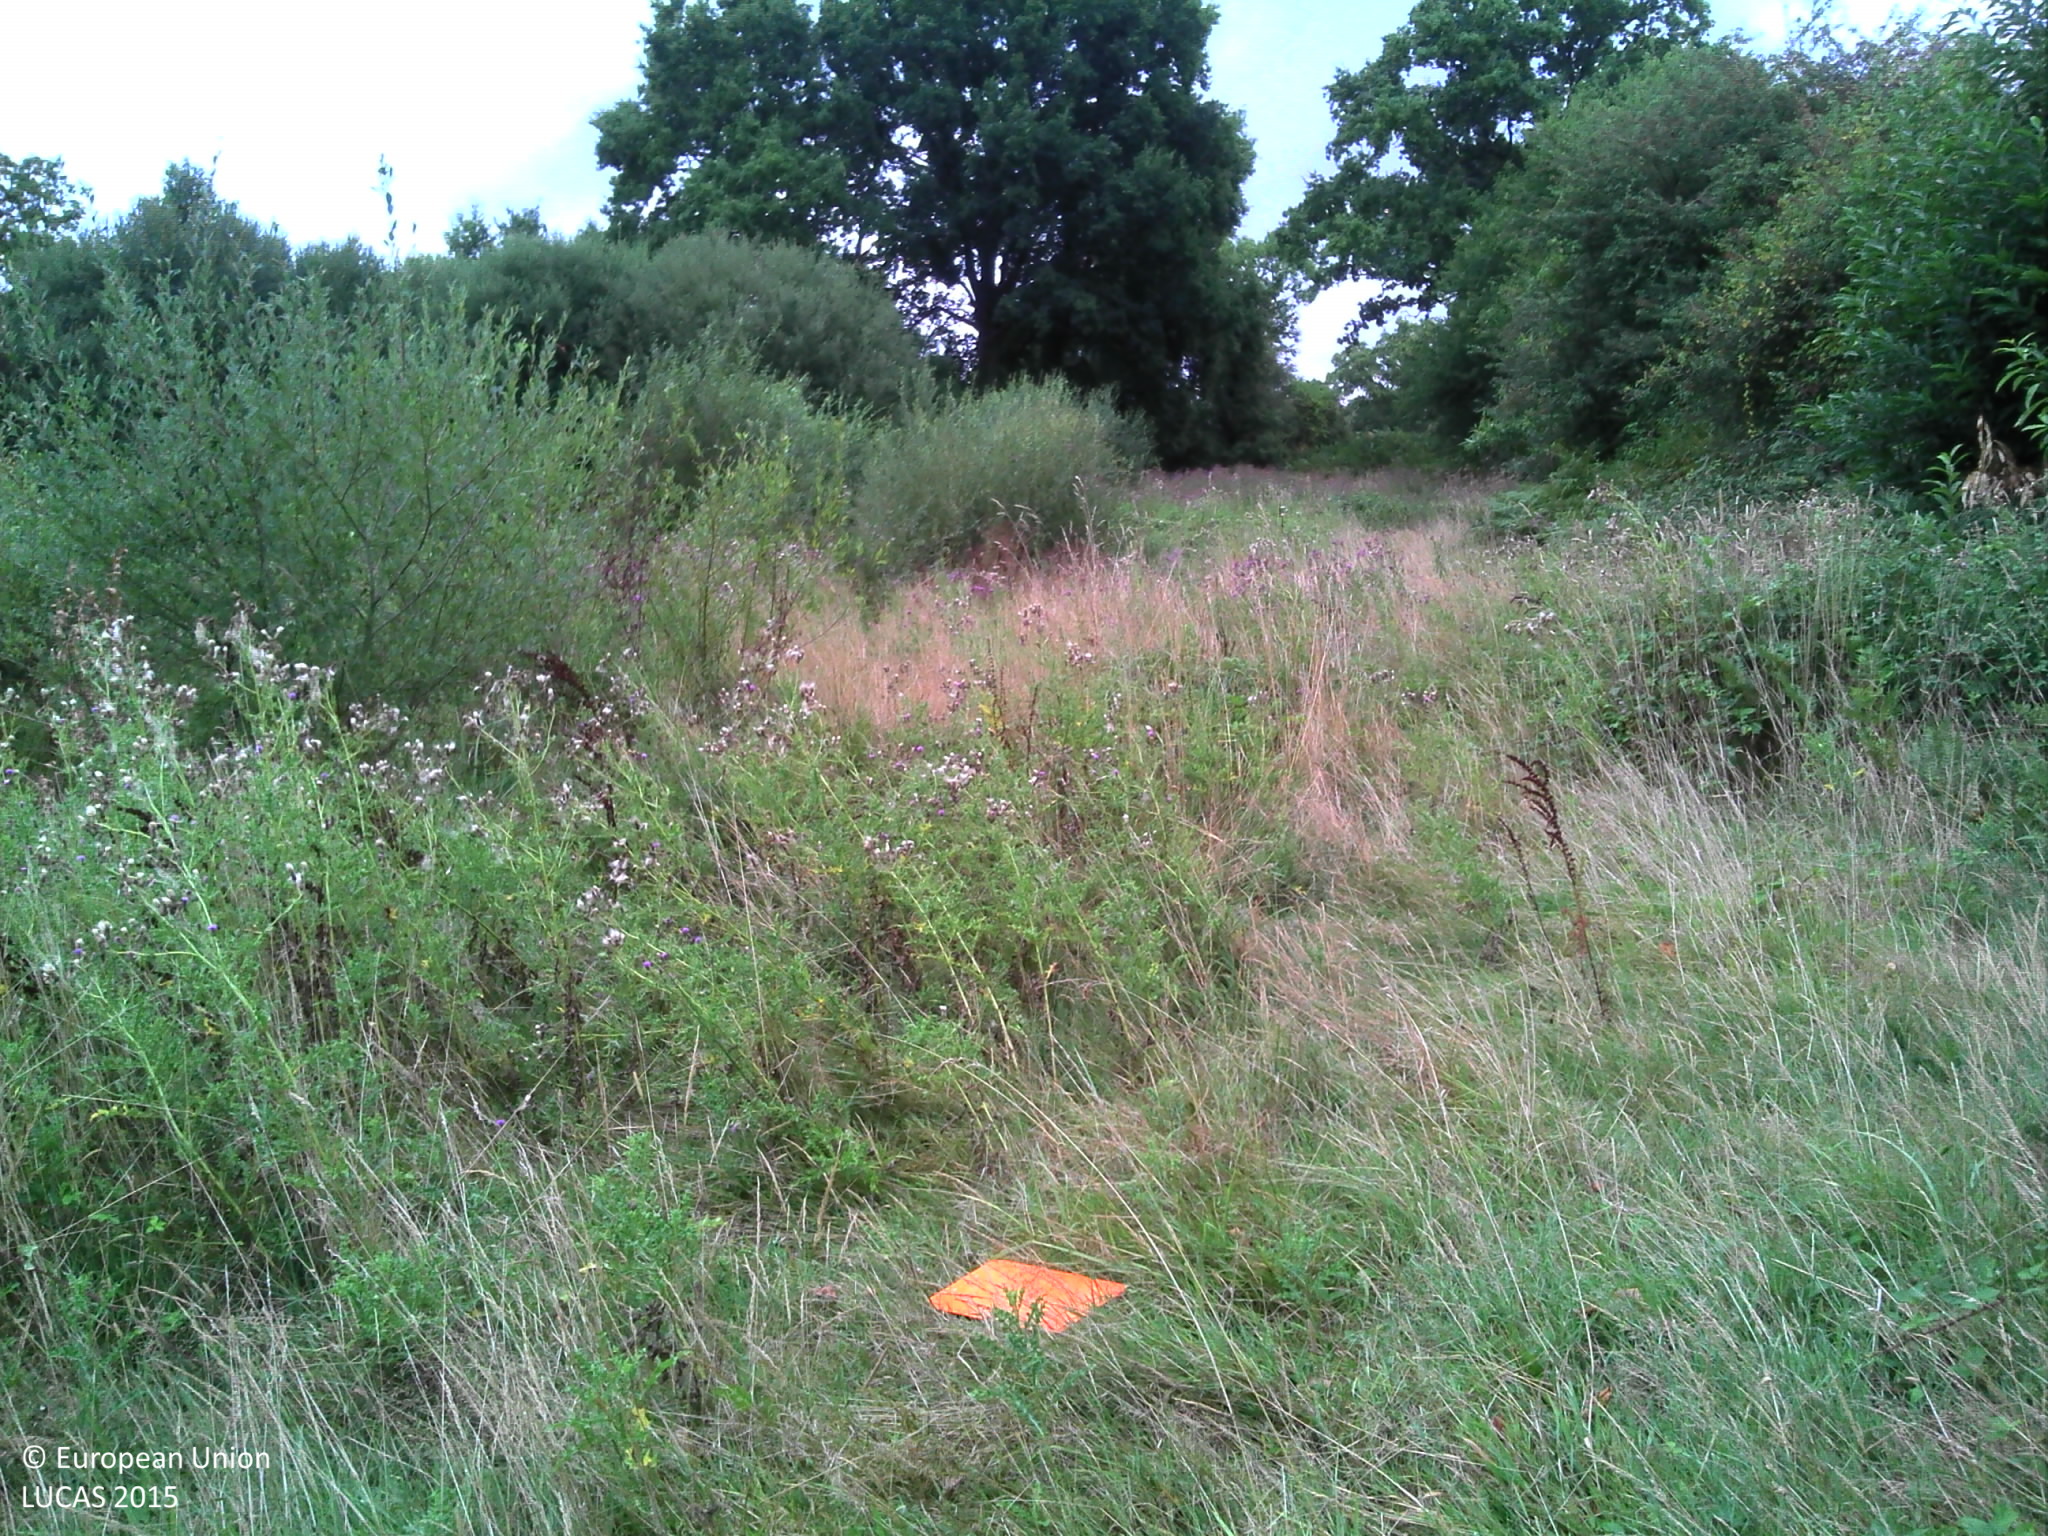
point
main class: Grassland
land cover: Spontaneously vegetated surfaces
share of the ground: > 75 %
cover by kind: herbaceous plants 95 %, shrubs 5 %
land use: Abandoned areas
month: August
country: FR
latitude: 47.5635
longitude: -1.5136
